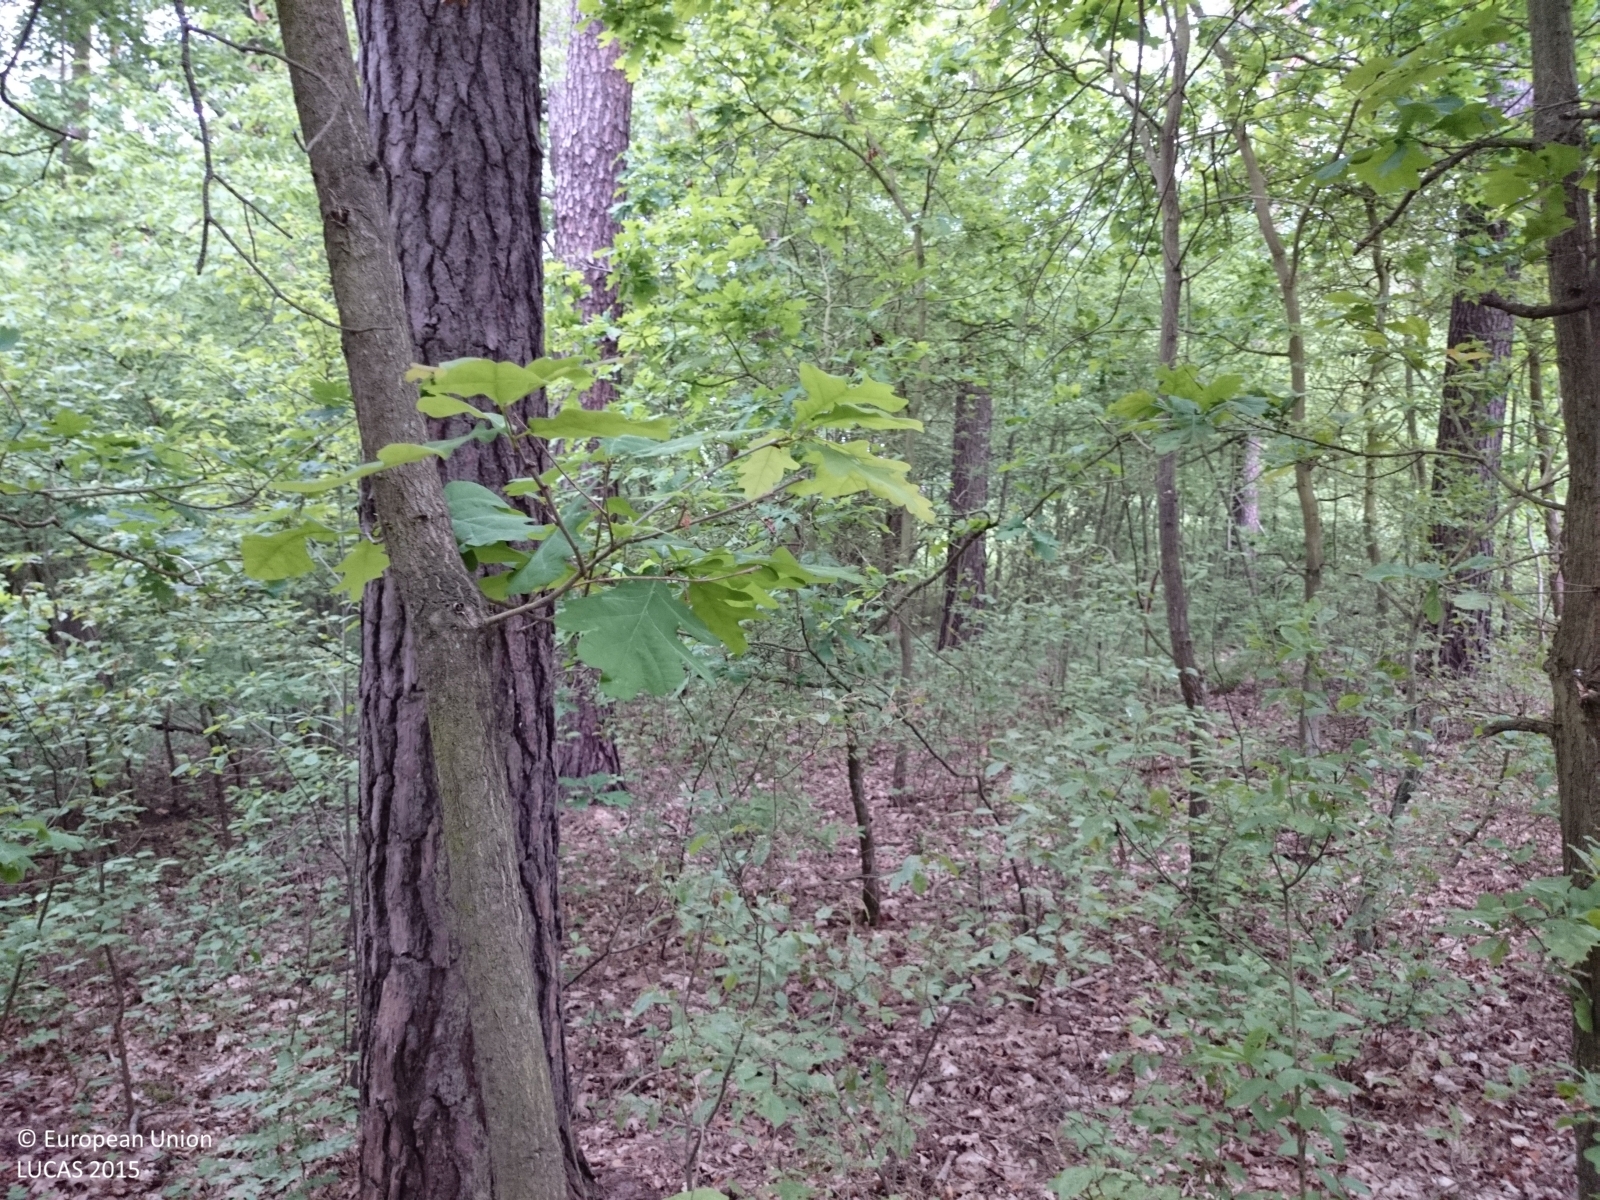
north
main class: Woodland
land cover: Pine dominated mixed woodland
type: hemiboreal forest and nemoral coniferous forest and mixed broadleaved-coniferous forest
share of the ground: > 75 %
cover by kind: coniferous forest trees 75 %, broadleaved forest trees 25 %
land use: Forestry
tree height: > 5 m
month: May
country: PL
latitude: 52.6029
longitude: 15.6595
